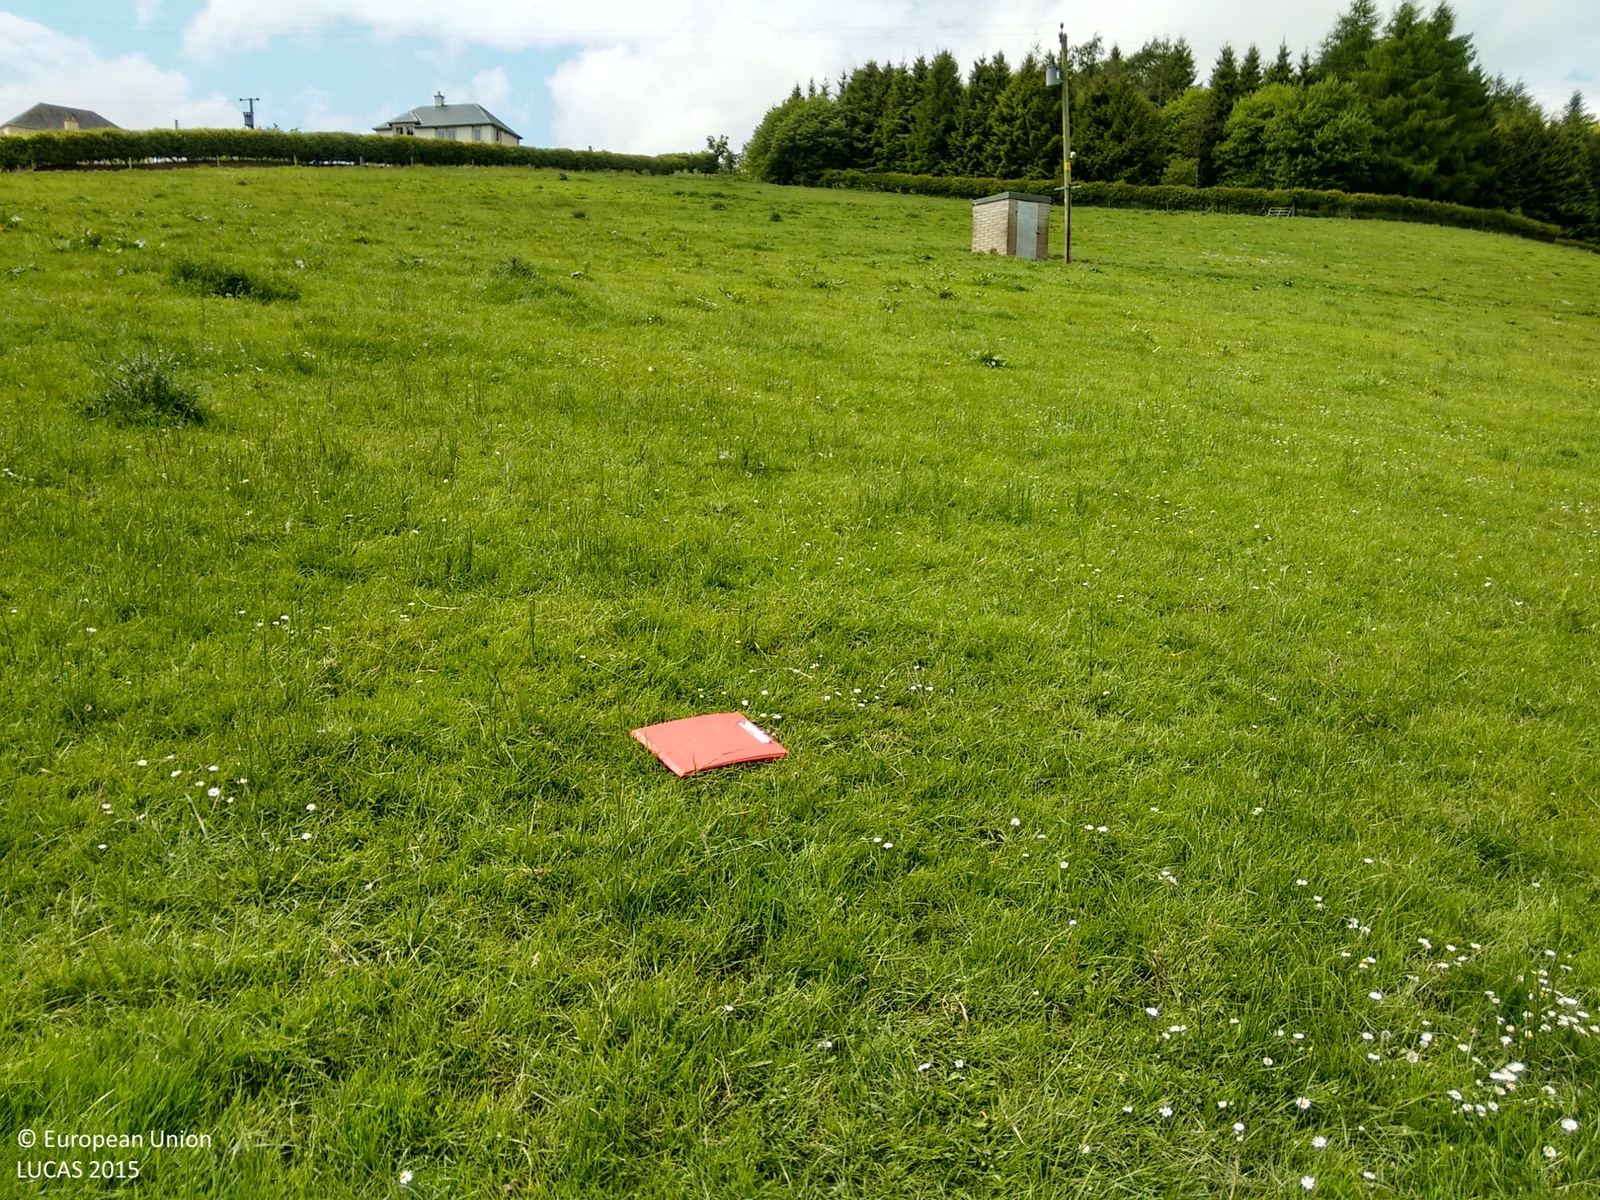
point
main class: Grassland
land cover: Grassland without tree/shrub cover
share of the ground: > 75 %
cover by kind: herbaceous plants 100 %
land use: Agriculture (excluding fallow land and kitchen gardens)
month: June
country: GB
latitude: 56.2939
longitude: -3.3054
